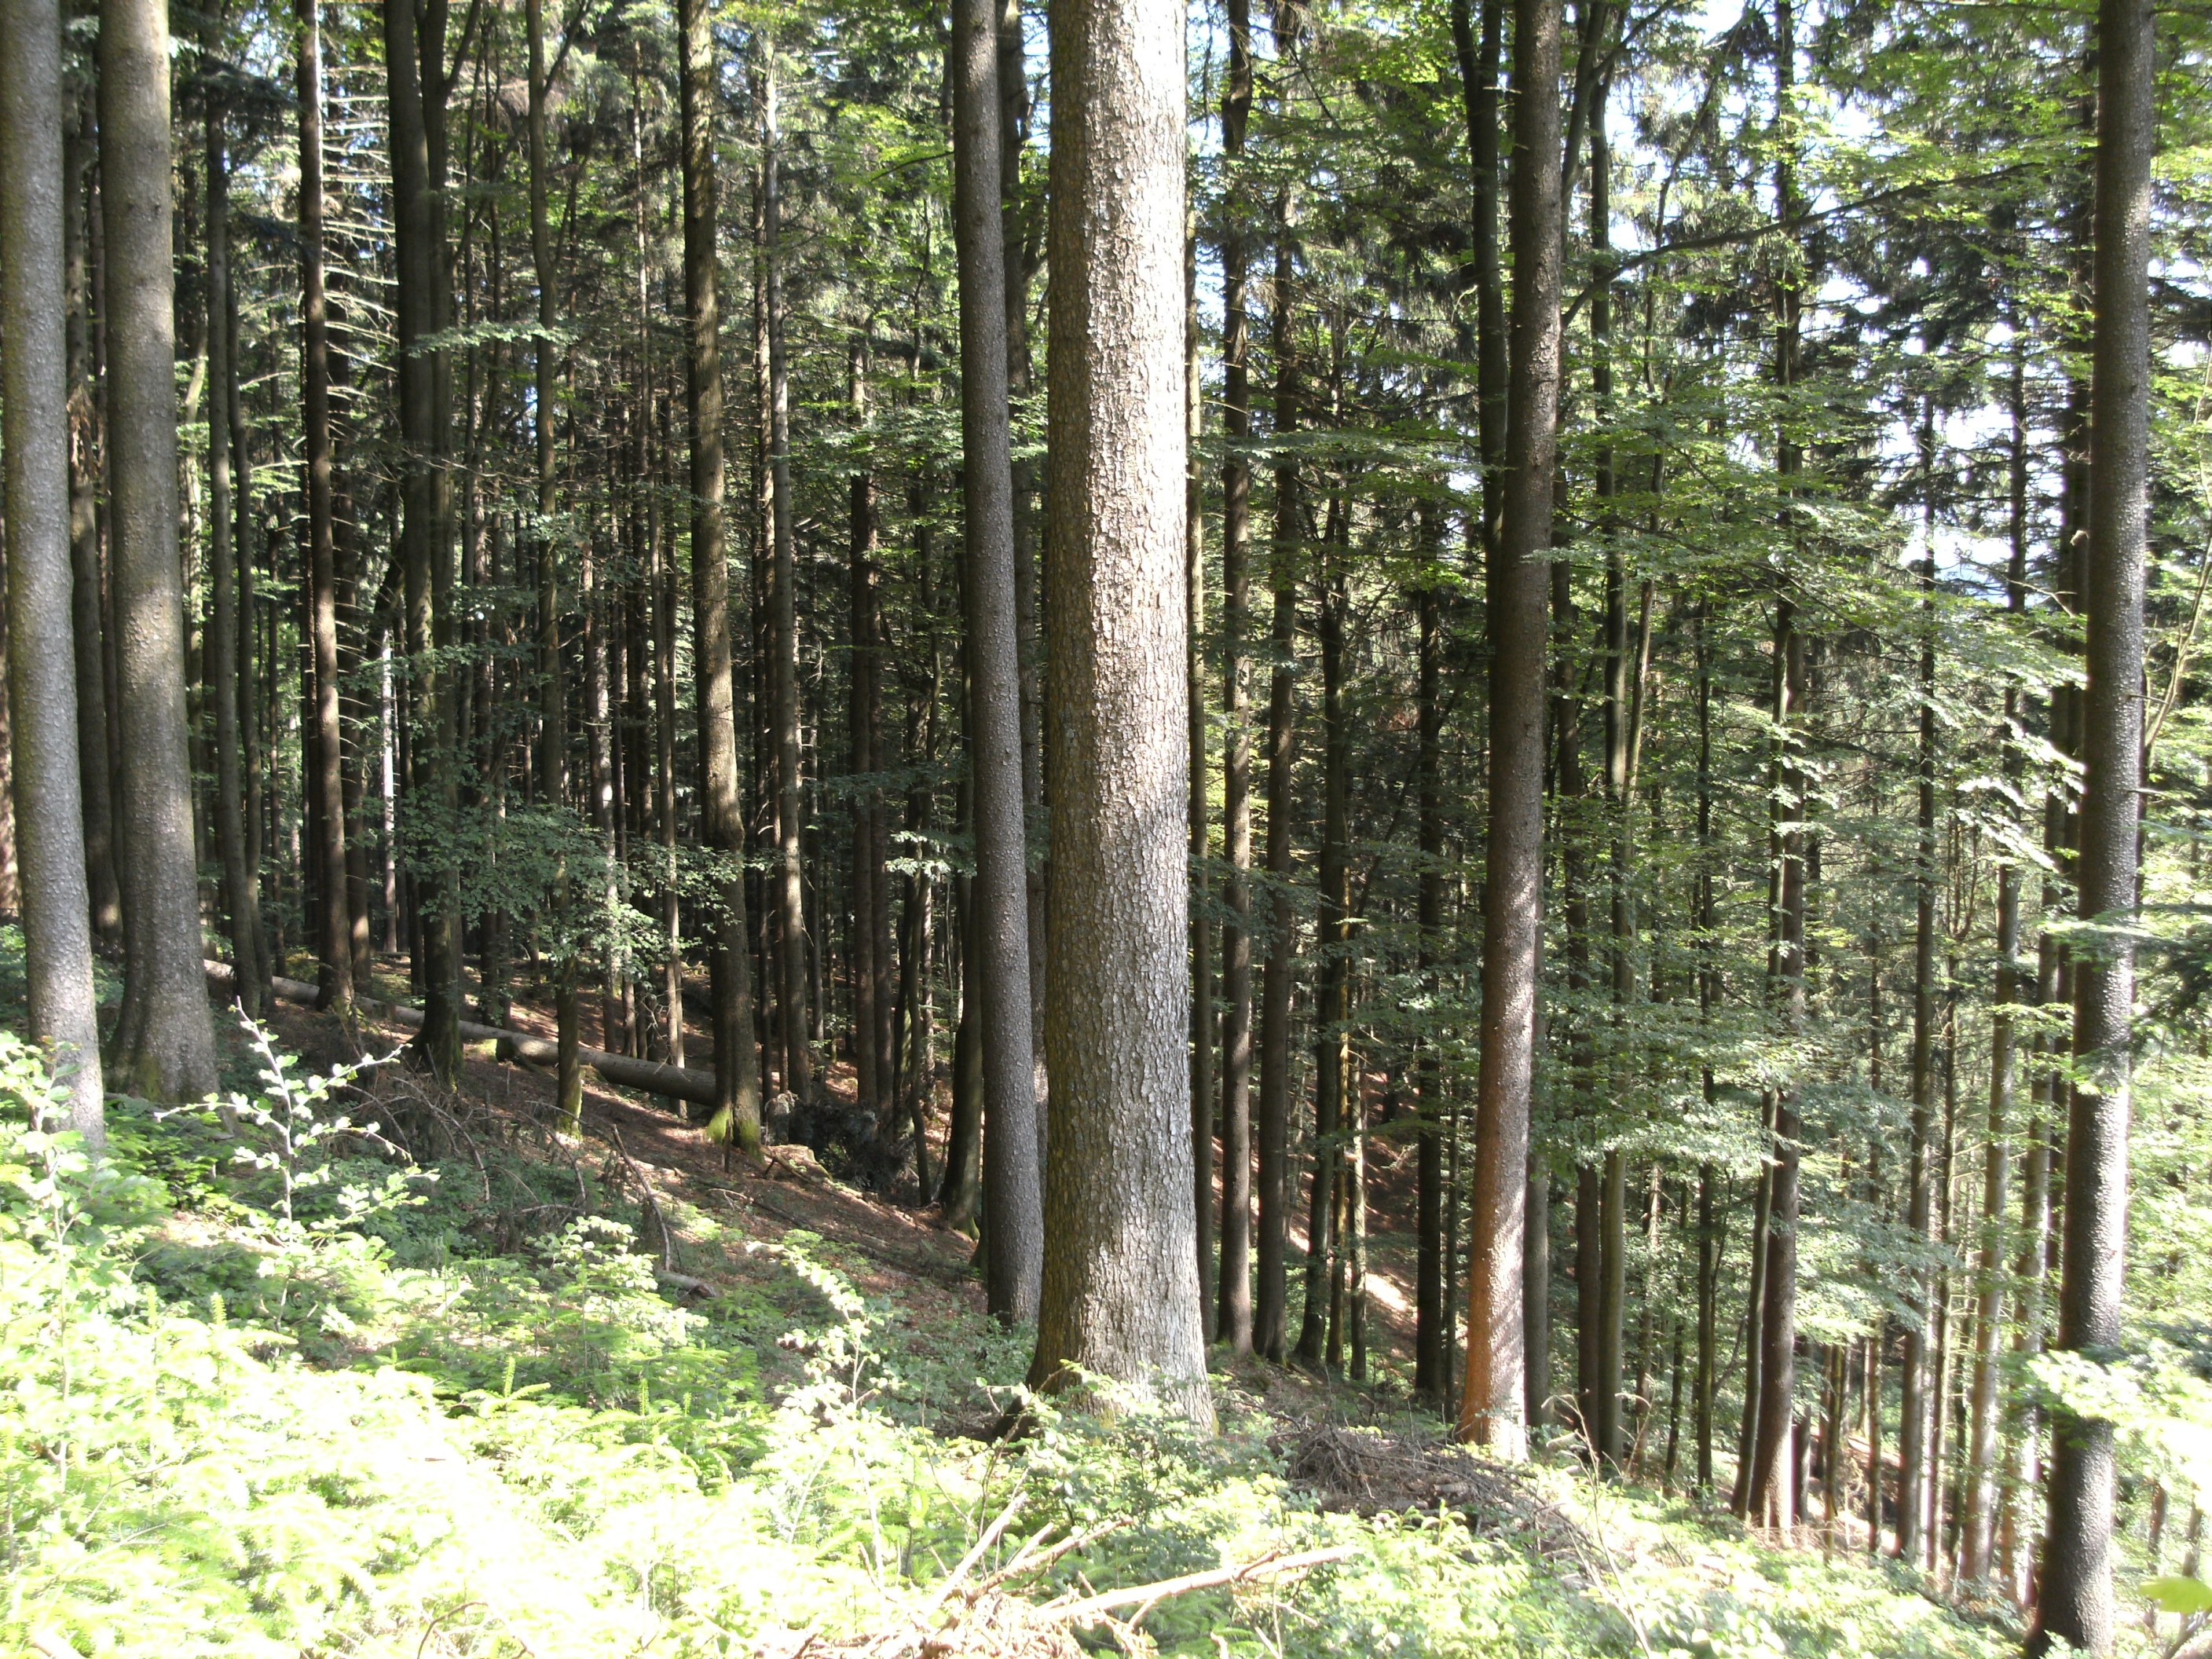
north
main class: Woodland
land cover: Other mixed woodland
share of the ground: > 75 %
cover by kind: coniferous forest trees 55 %, broadleaved forest trees 35 %, herbaceous plants 10 %
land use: Forestry
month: June
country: AT
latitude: 48.1112
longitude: 13.5854
